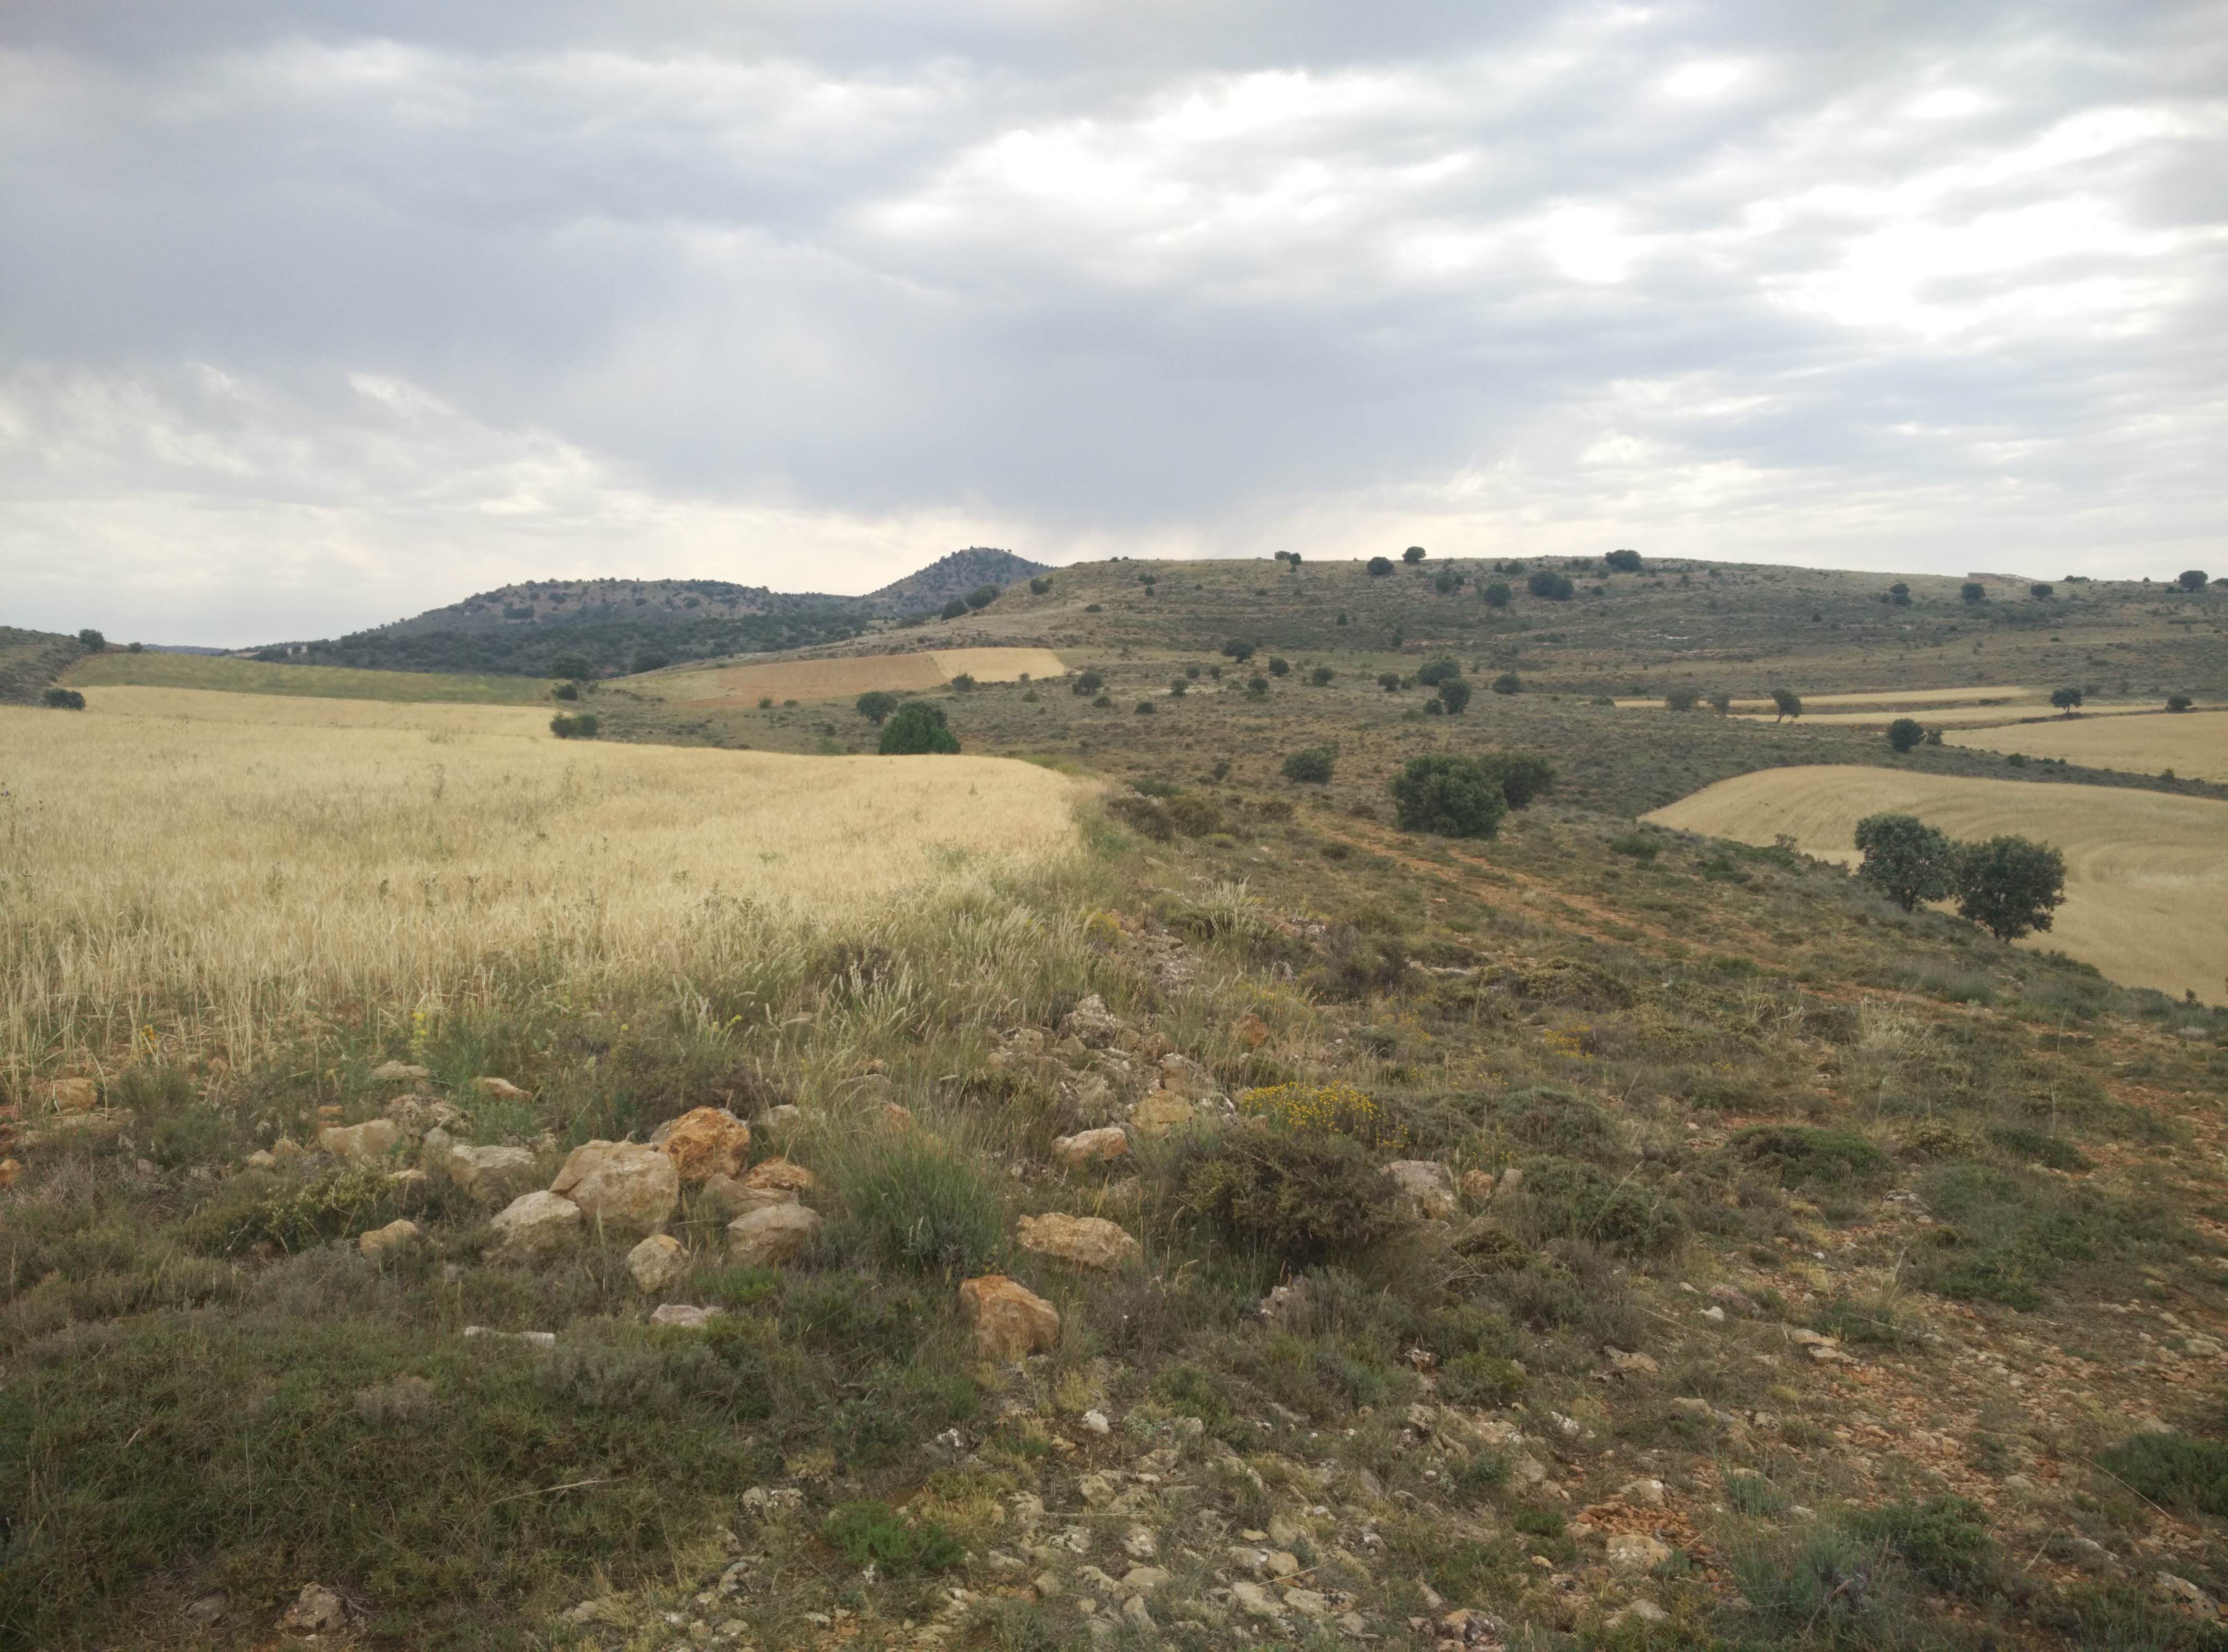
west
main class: Shrubland
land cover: Shrubland without tree cover
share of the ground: > 75 %
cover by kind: shrubs 80 %, unconsolidated bare surface 20 %
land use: Semi-natural and natural areas not in use
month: July
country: ES
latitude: 41.0602
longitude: -1.8641
